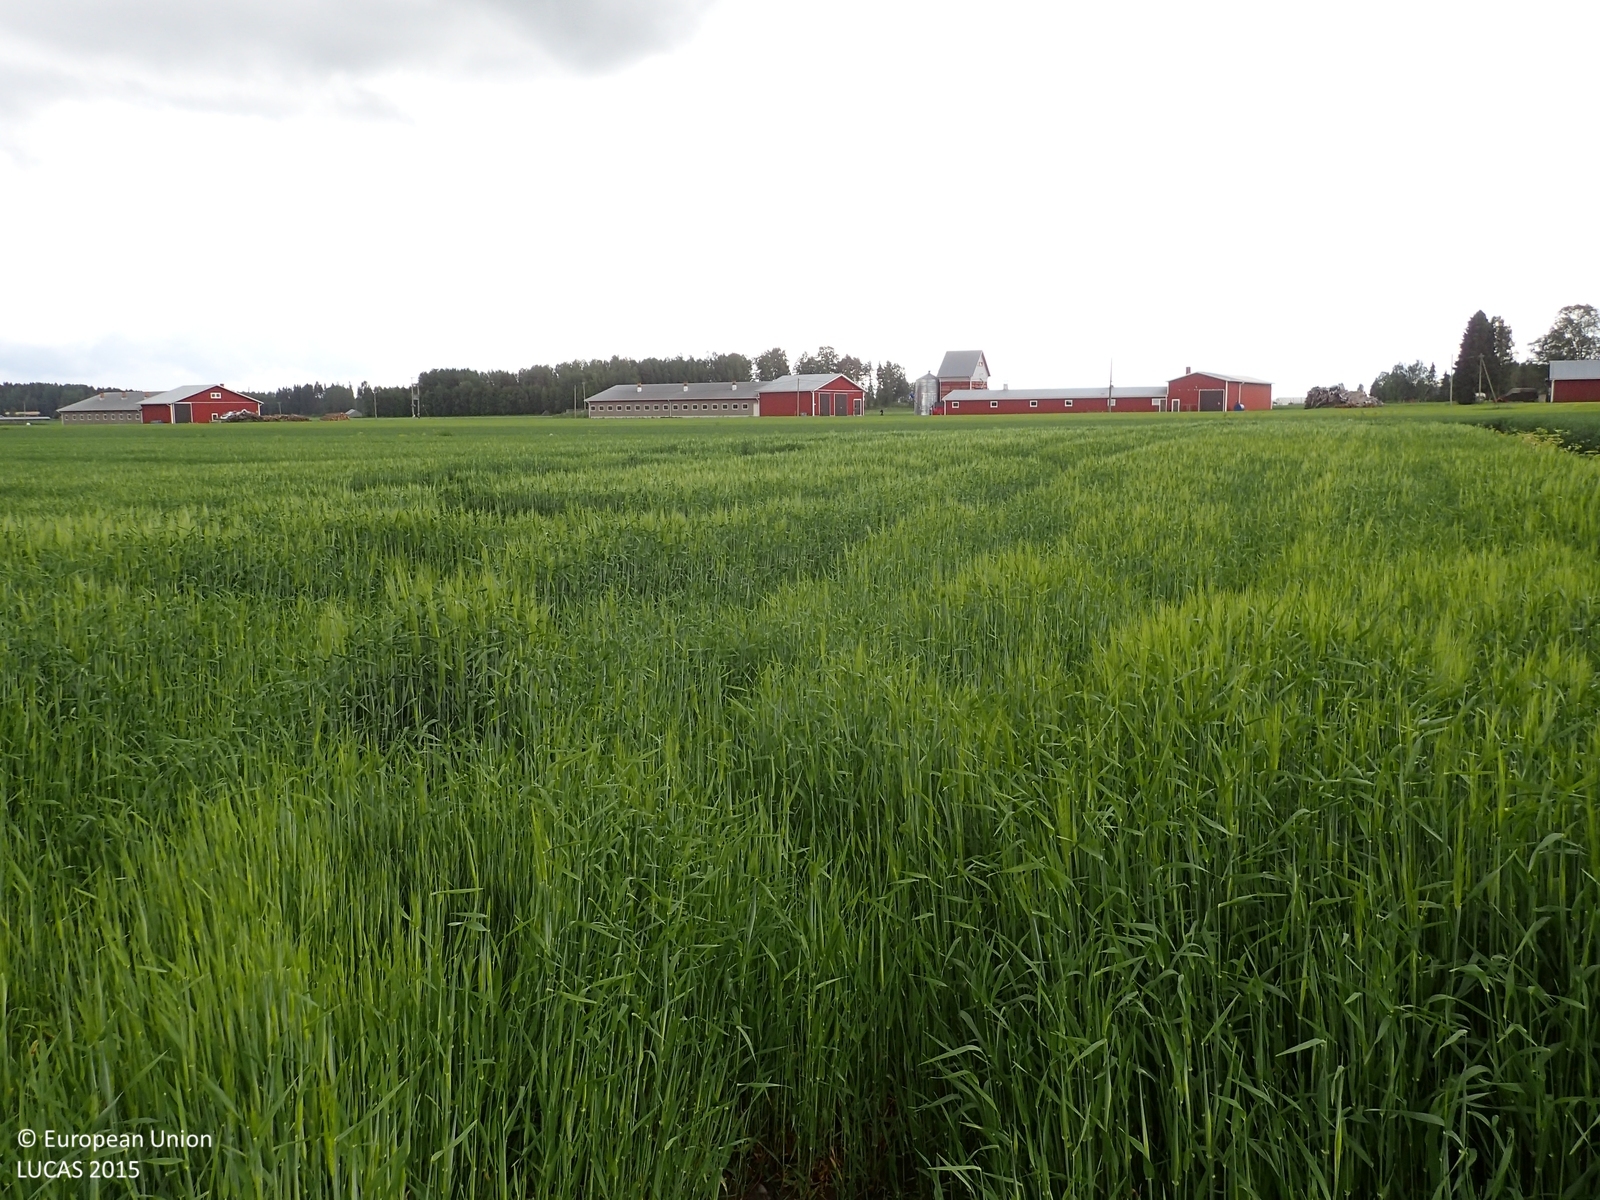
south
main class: Cropland
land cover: Arable land (only in case pi)
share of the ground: > 75 %
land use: Agriculture (excluding fallow land and kitchen gardens)
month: July
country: FI
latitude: 62.9234
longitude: 21.6801
